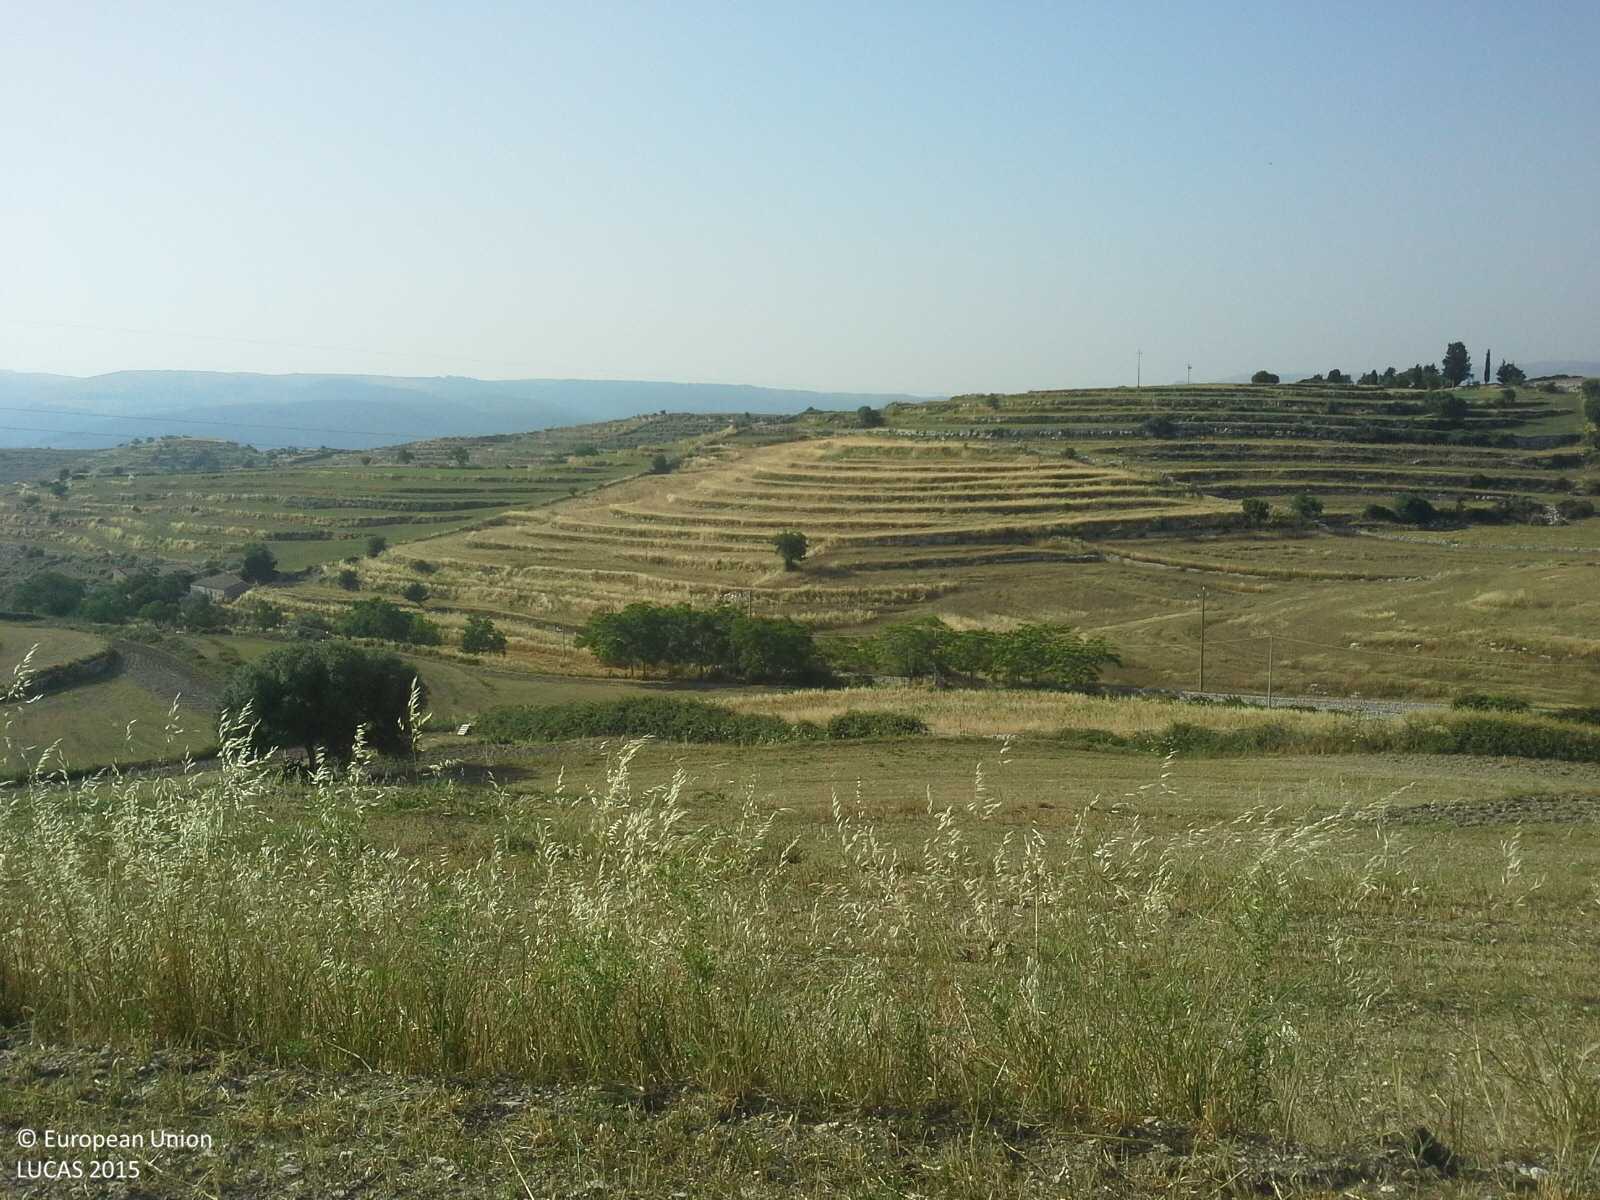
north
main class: Cropland
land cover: Mixed cereals for fodder
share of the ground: > 75 %
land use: Agriculture (excluding fallow land and kitchen gardens)
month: June
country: IT
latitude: 36.9713
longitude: 14.8036
